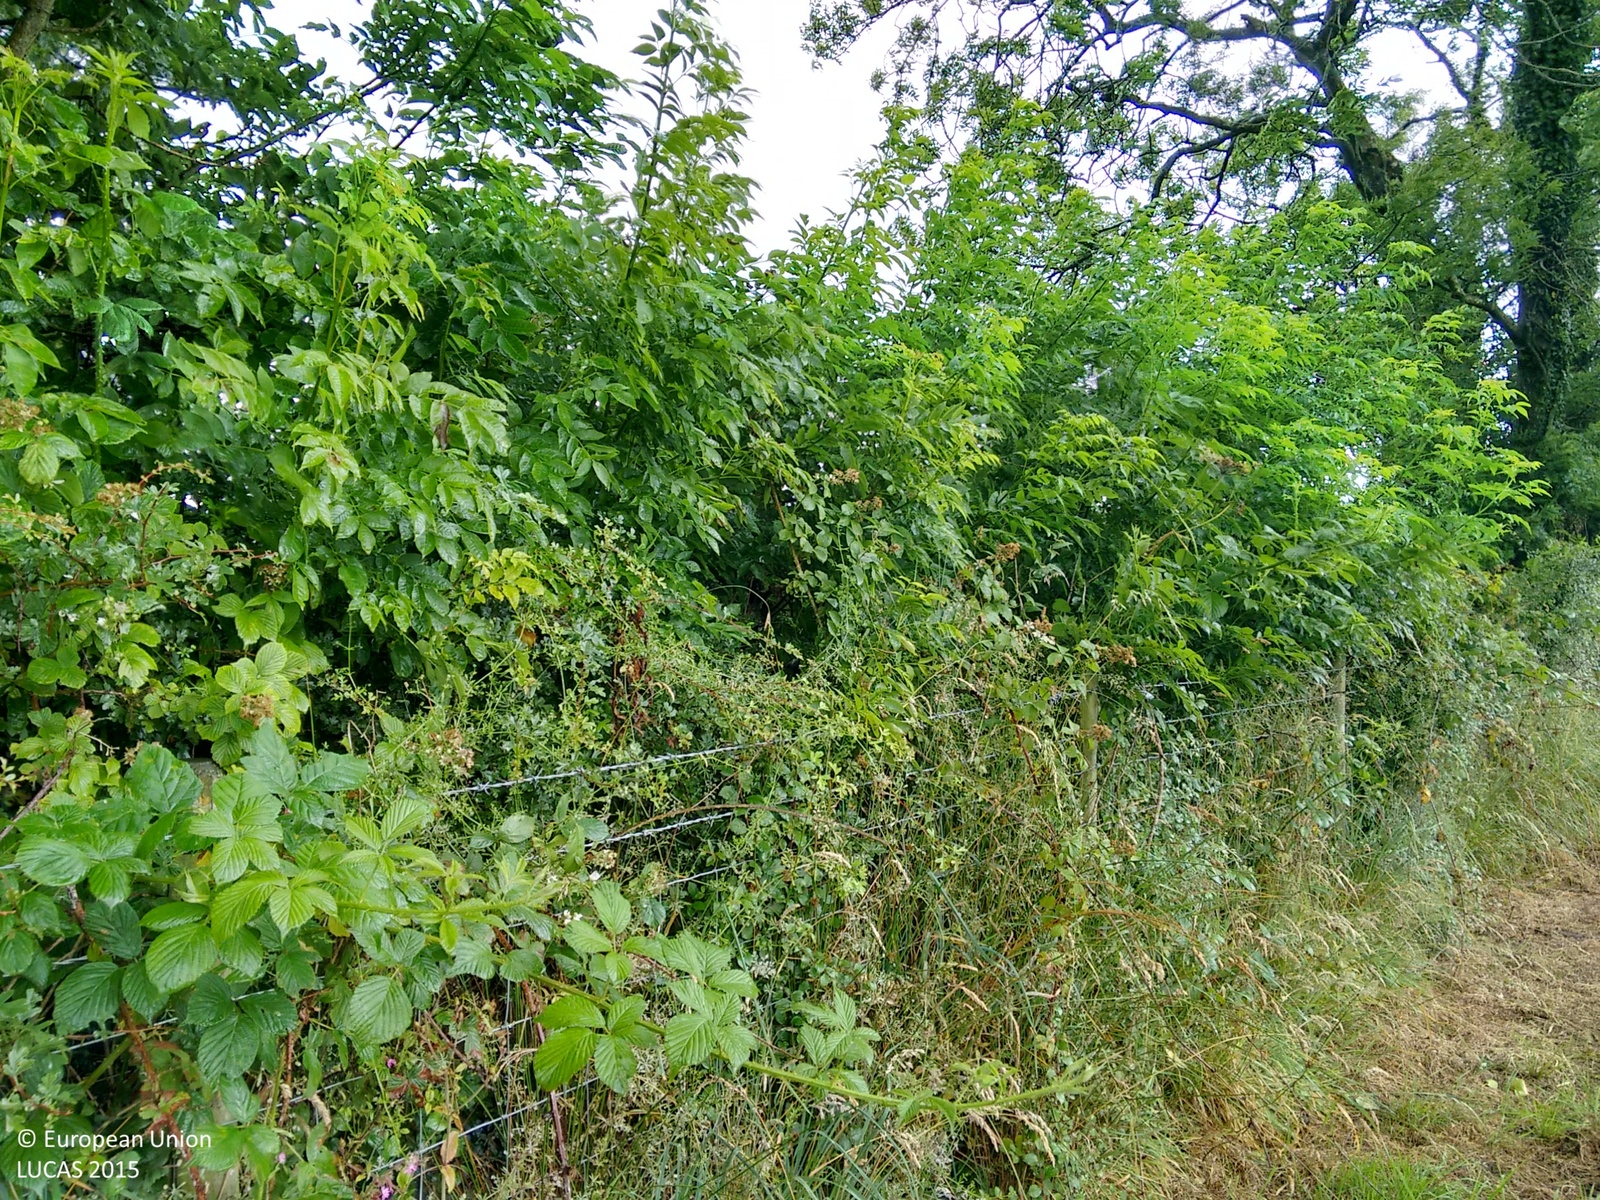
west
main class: Cropland
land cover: Other root crops
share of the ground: > 75 %
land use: Agriculture (excluding fallow land and kitchen gardens)
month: August
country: GB
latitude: 51.9421
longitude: -4.6114
